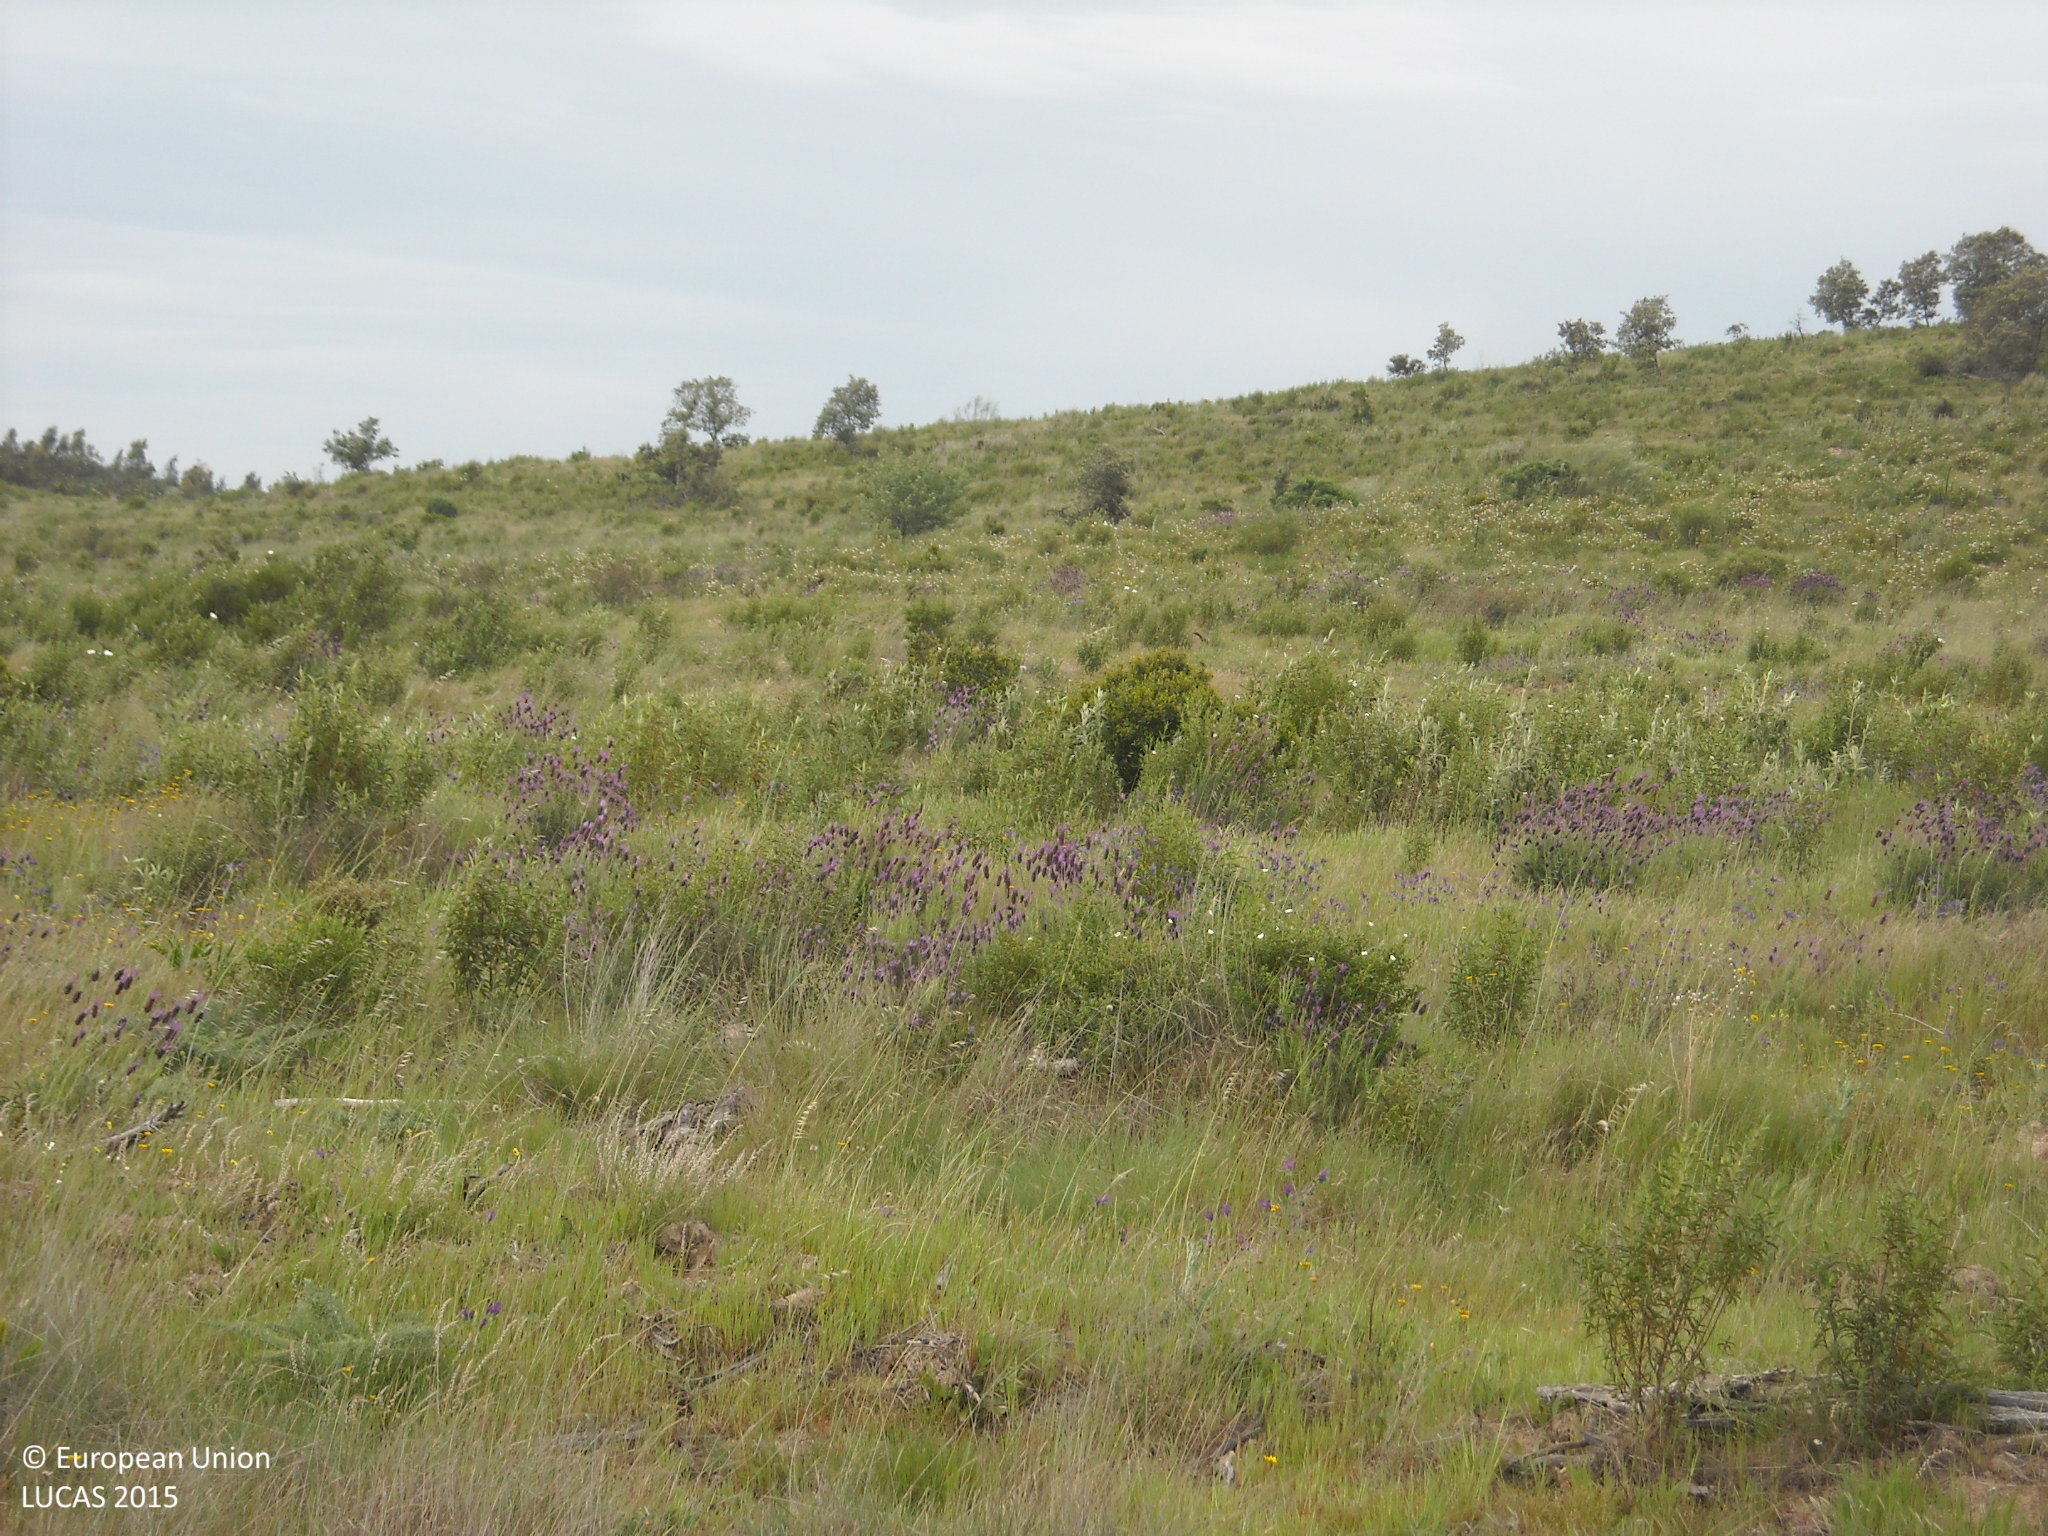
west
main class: Shrubland
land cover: Shrubland without tree cover
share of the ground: 10 - 25 %
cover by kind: herbaceous plants 80 %, shrubs 20 %
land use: Agriculture (excluding fallow land and kitchen gardens)
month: April
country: ES
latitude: 37.6351
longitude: -6.2257
